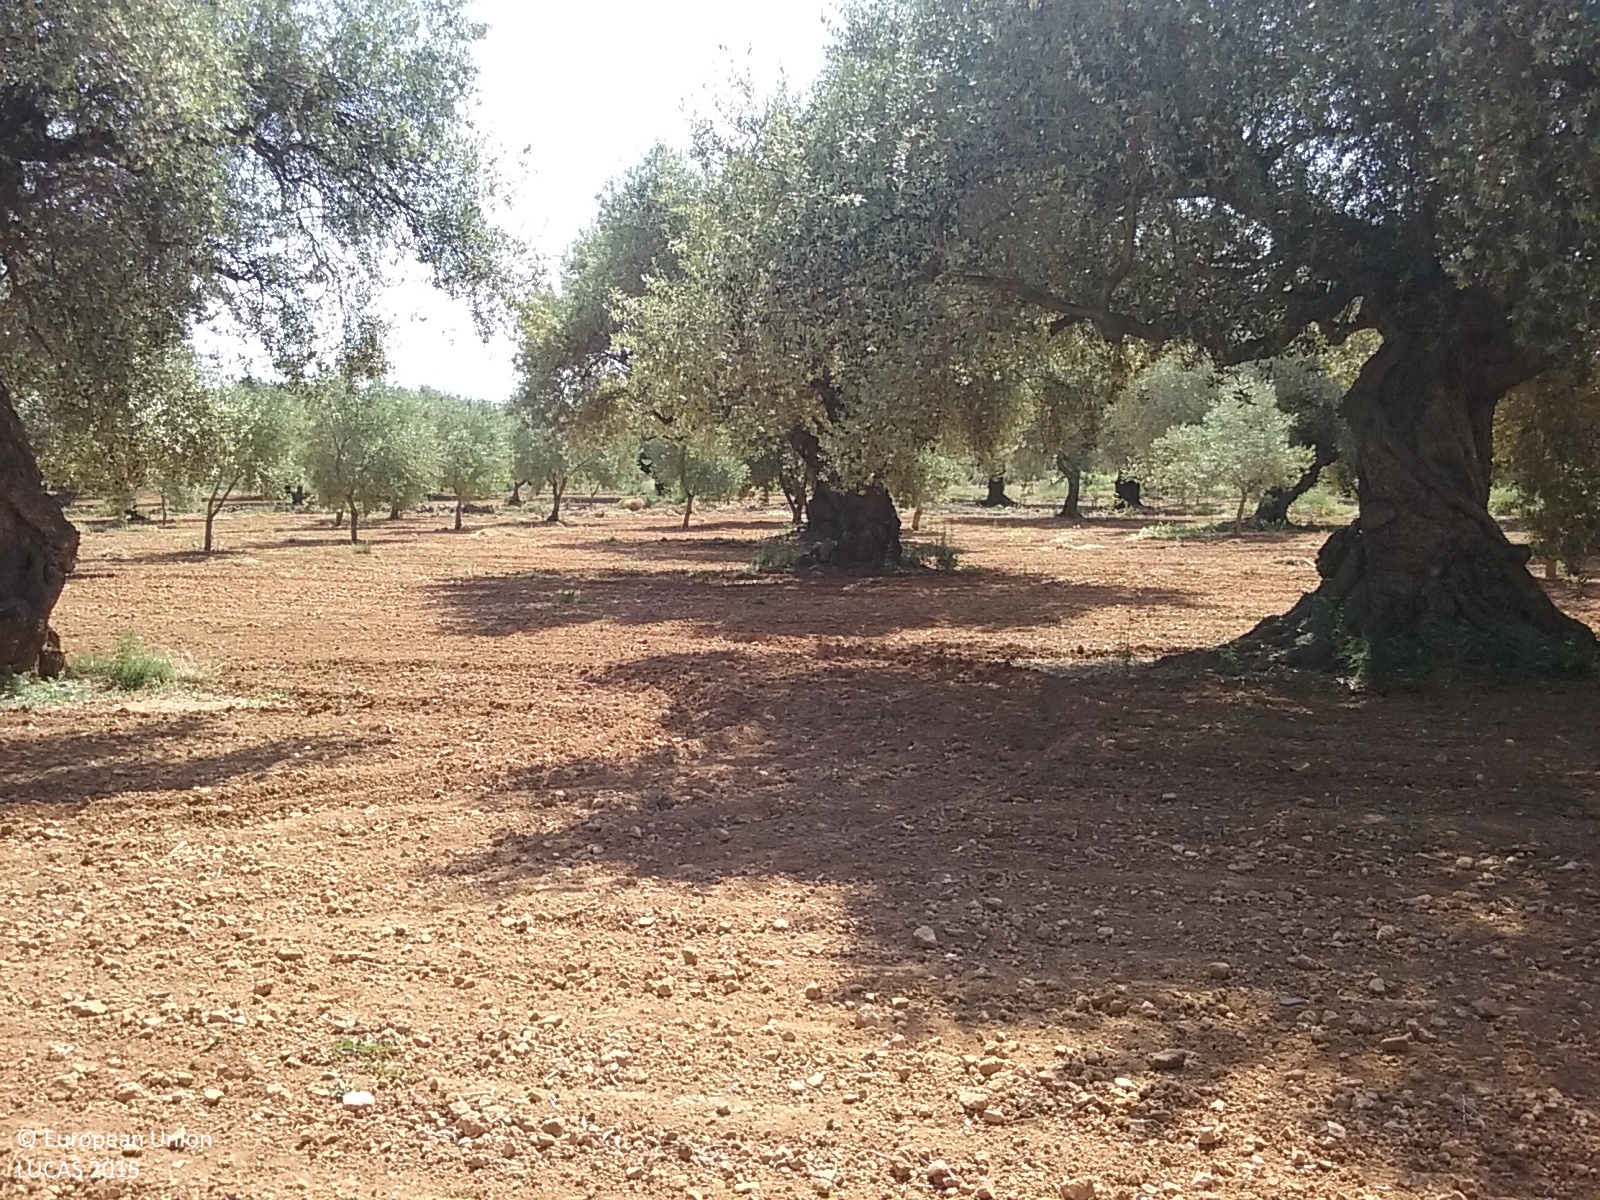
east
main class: Cropland
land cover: Olive groves
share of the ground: 50 - 75 %
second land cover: Other bare soil
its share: > 75 %
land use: Agriculture (excluding fallow land and kitchen gardens)
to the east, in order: Olive groves; Other bare soil; Dry stone walls; Olive groves; Dry stone walls; Olive groves; Dry stone walls; Paved roads, cycling and walking lanes; Artificial constructions; Olive groves; Dry stone walls; Olive groves
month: May
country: ES
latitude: 40.5504
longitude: 0.3003
